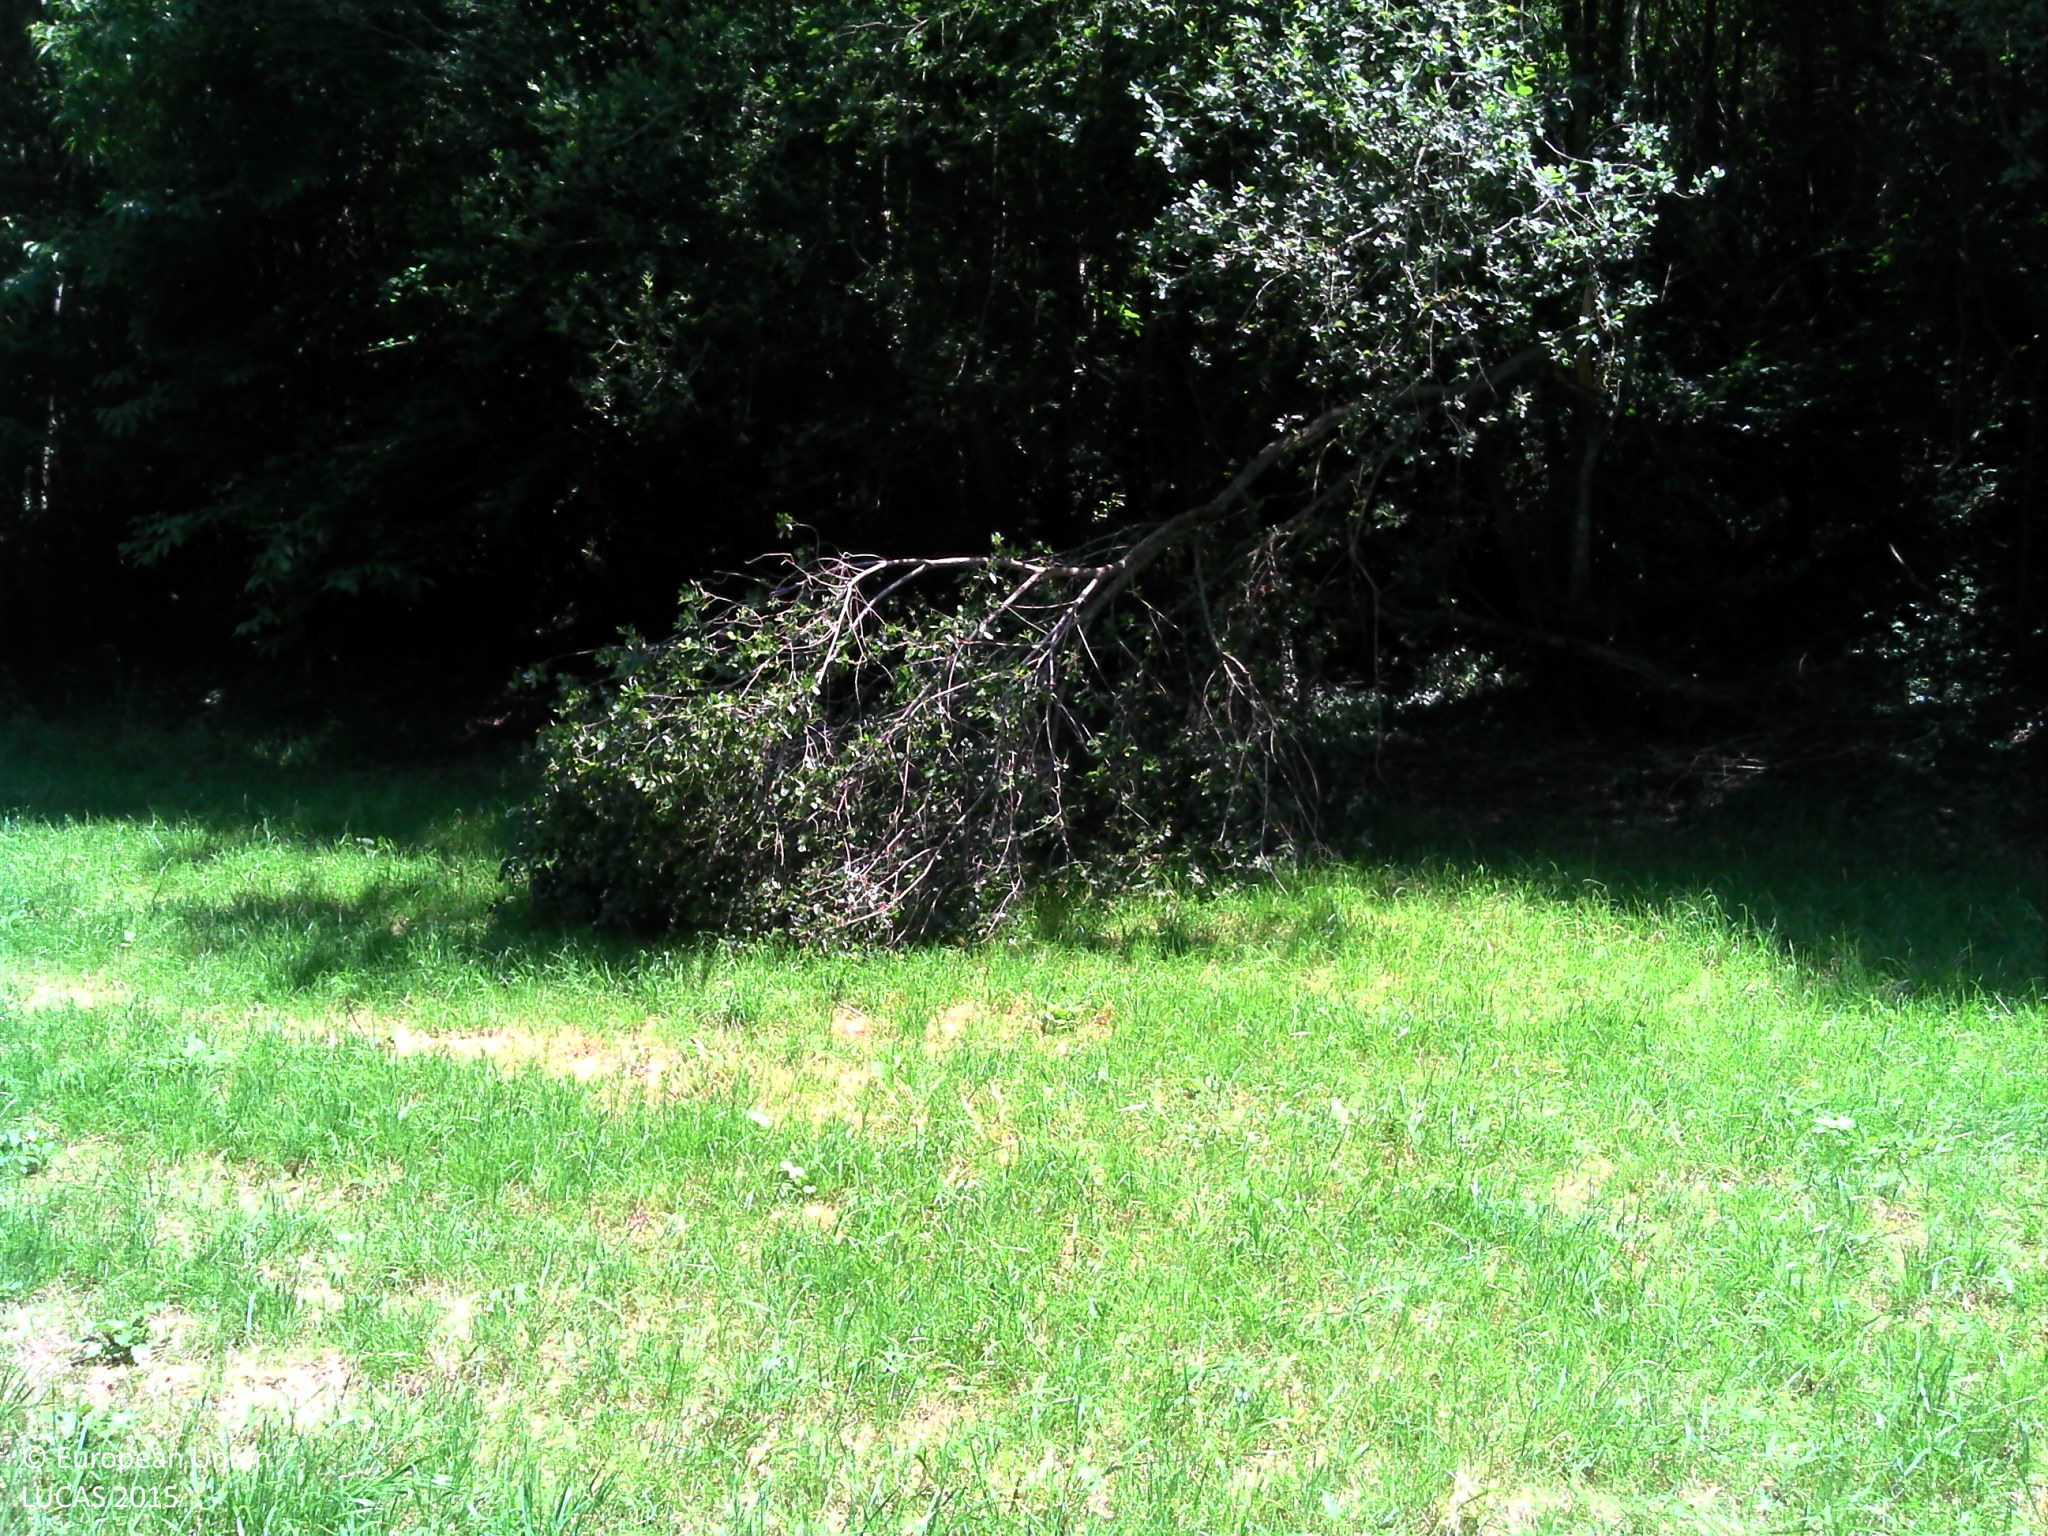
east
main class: Cropland
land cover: Temporary grasslands
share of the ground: > 75 %
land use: Agriculture (excluding fallow land and kitchen gardens)
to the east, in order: Temporary grasslands; Fences; Broadleaved woodland; Tracks; Broadleaved woodland; Common wheat
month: June
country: FR
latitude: 43.1635
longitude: -0.1264
